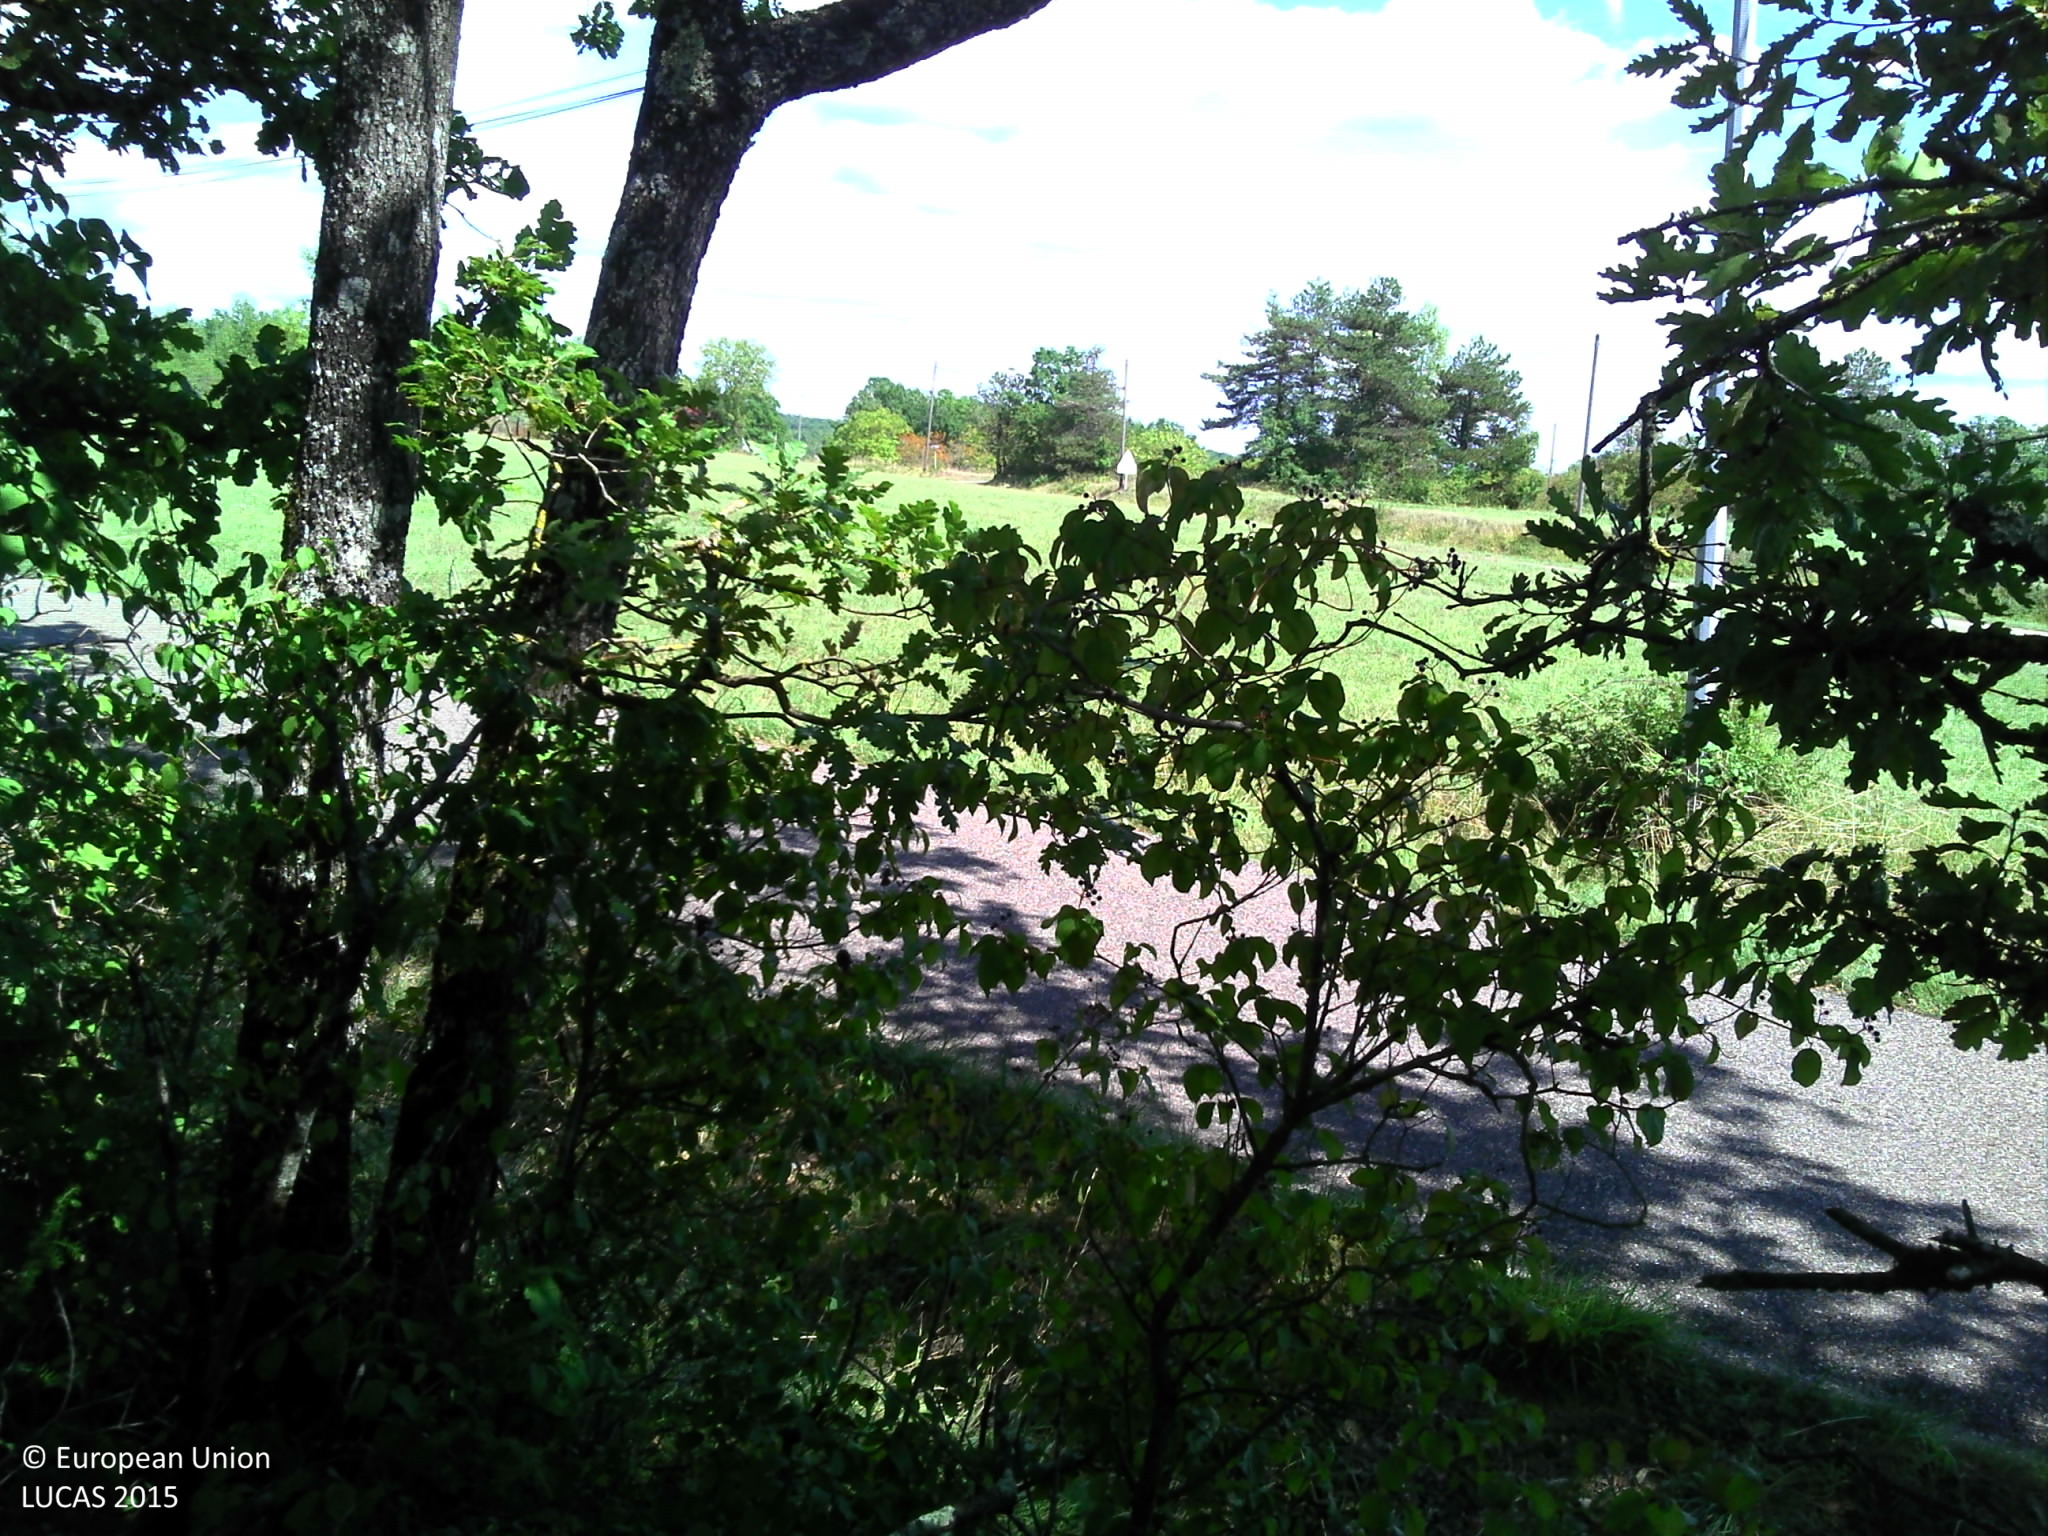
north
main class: Grassland
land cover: Spontaneously vegetated surfaces
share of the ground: 10 - 25 %
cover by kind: consolidated bare surface 75 %, herbaceous plants 25 %
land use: Agriculture (excluding fallow land and kitchen gardens)
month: August
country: FR
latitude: 44.2547
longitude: 1.4952
